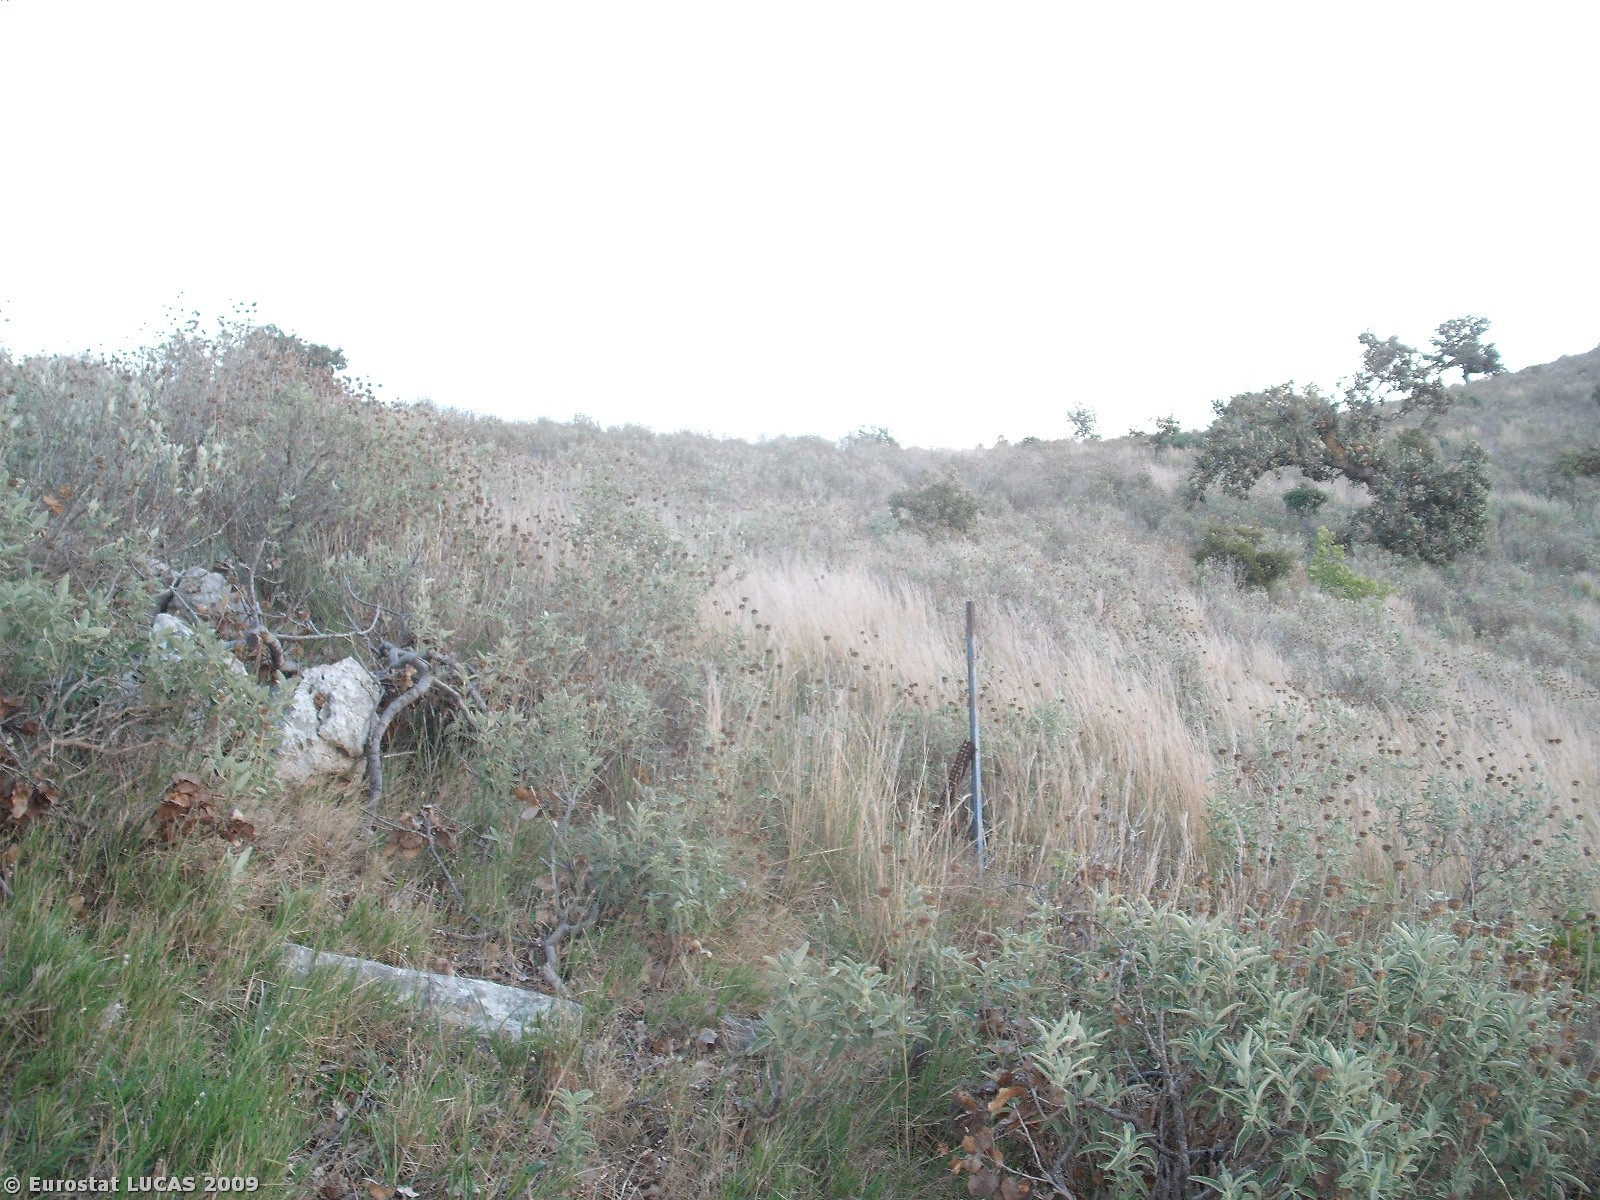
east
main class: Shrubland
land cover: Shrubland without tree cover
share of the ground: > 75 %
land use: Nature reserves
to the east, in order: Shrubland without tree cover
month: October
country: GR
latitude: 38.1792
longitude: 21.3690
